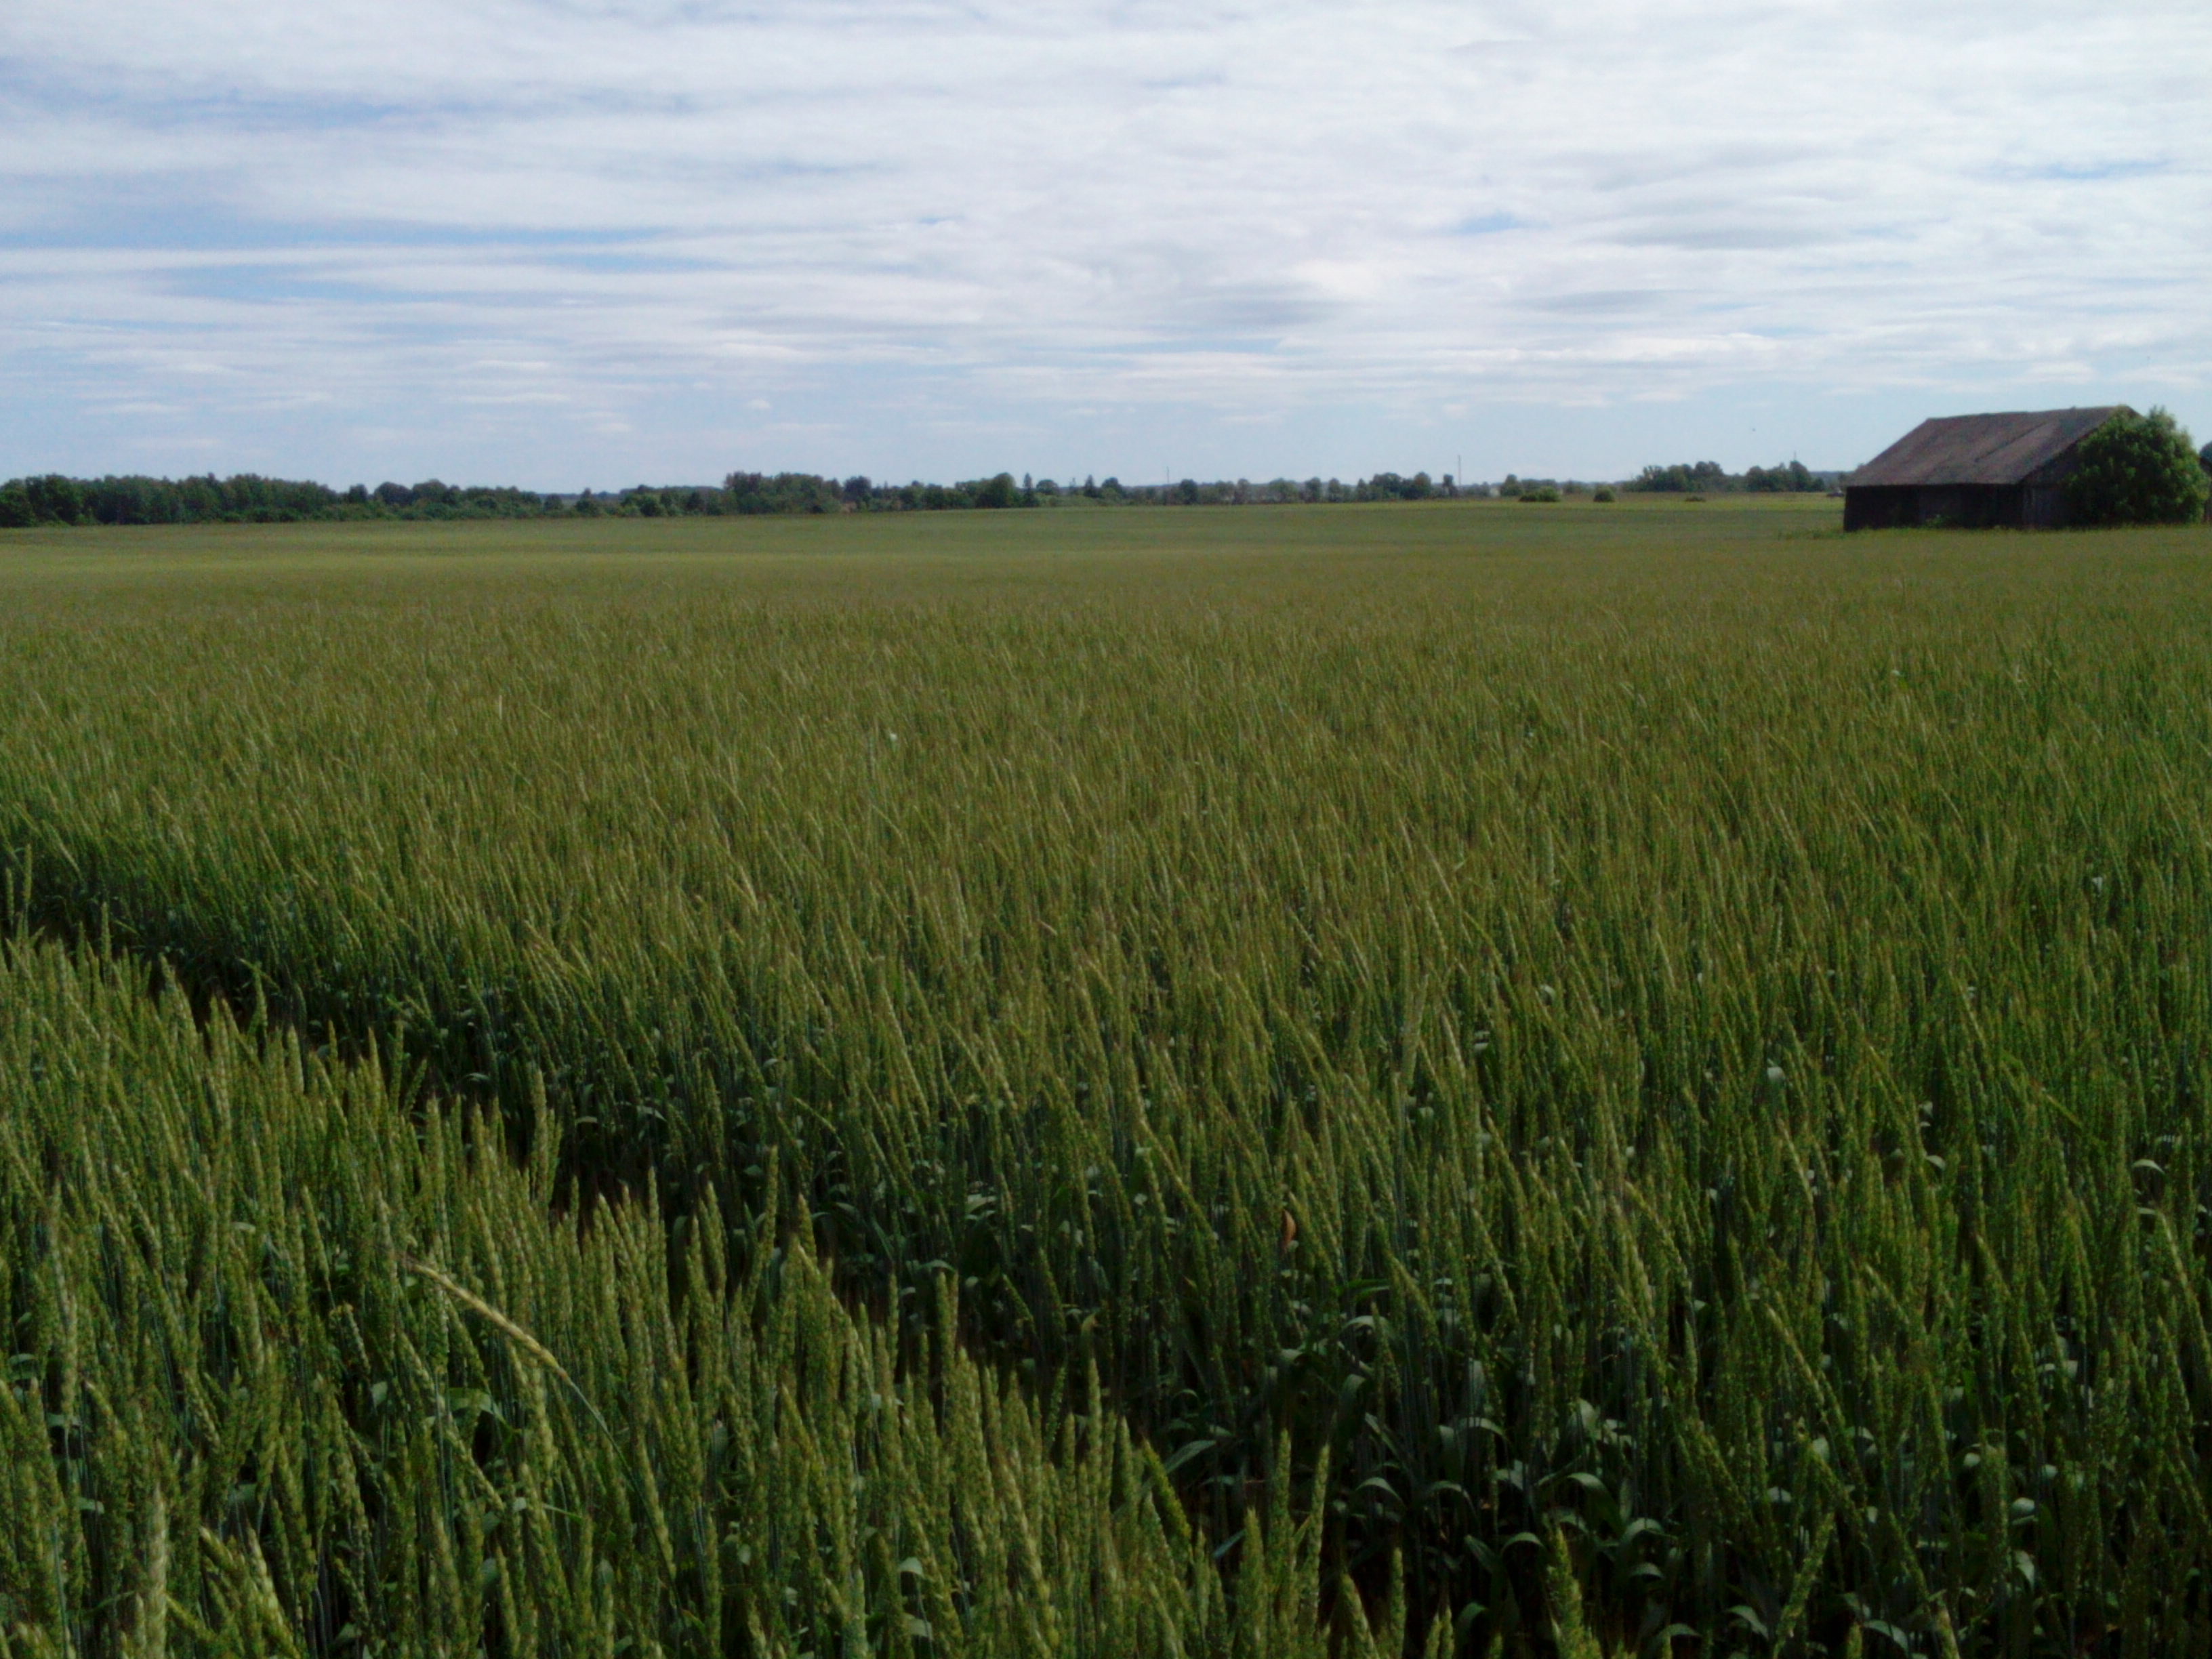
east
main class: Cropland
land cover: Common wheat
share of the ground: > 75 %
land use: Agriculture (excluding fallow land and kitchen gardens)
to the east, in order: Common wheat
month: July
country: LV
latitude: 56.4612
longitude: 22.1751
